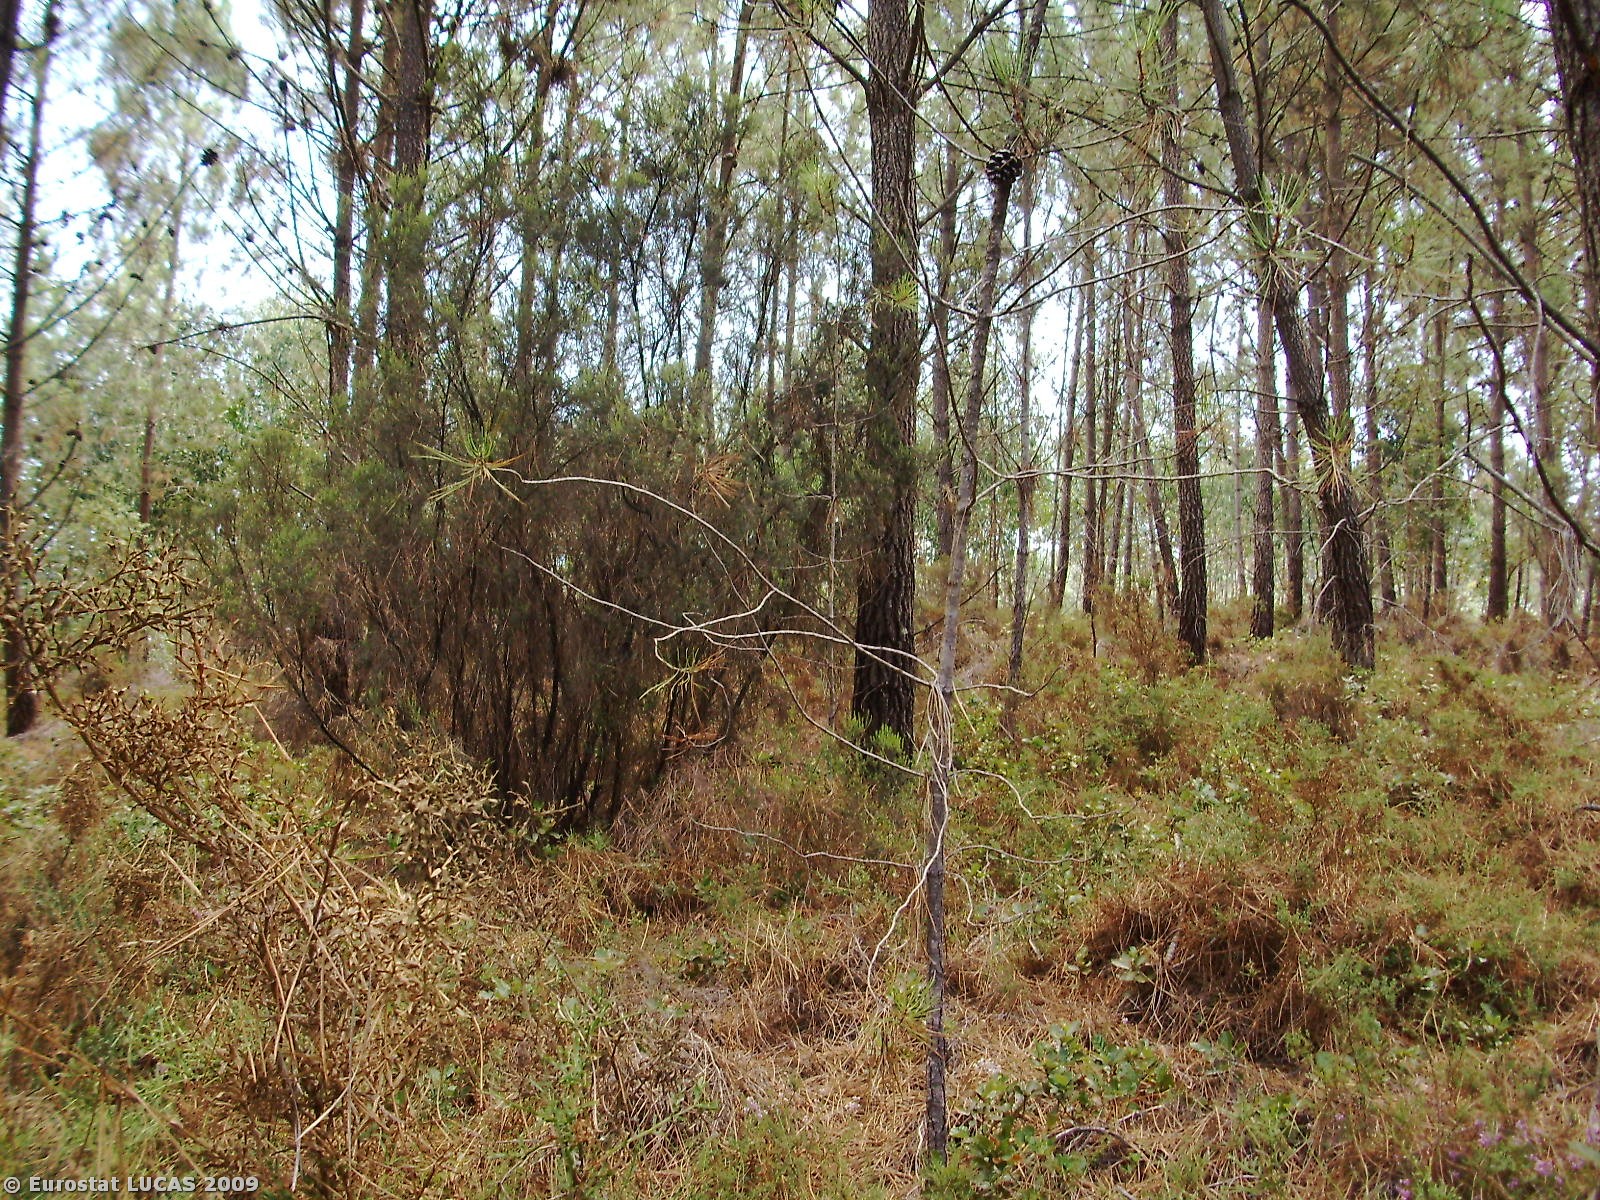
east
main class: Woodland
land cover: Coniferous woodland
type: coniferous forest of the mediterranean region
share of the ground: > 75 %
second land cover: Shrubland with sparse tree cover
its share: 10 - 25 %
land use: Forestry
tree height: > 5 m
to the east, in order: Coniferous woodland; Shrubland with sparse tree cover; Coniferous woodland; Broadleaved woodland; Shrubland with sparse tree cover; Tracks; Broadleaved woodland; Shrubland with sparse tree cover; Tracks; Broadleaved woodland; Shrubland with sparse tree cover; Tracks; Broadleaved woodland; Shrubland with sparse tree cover; Tracks; Broadleaved woodland
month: August
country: PT
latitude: 40.1109
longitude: -8.3467
